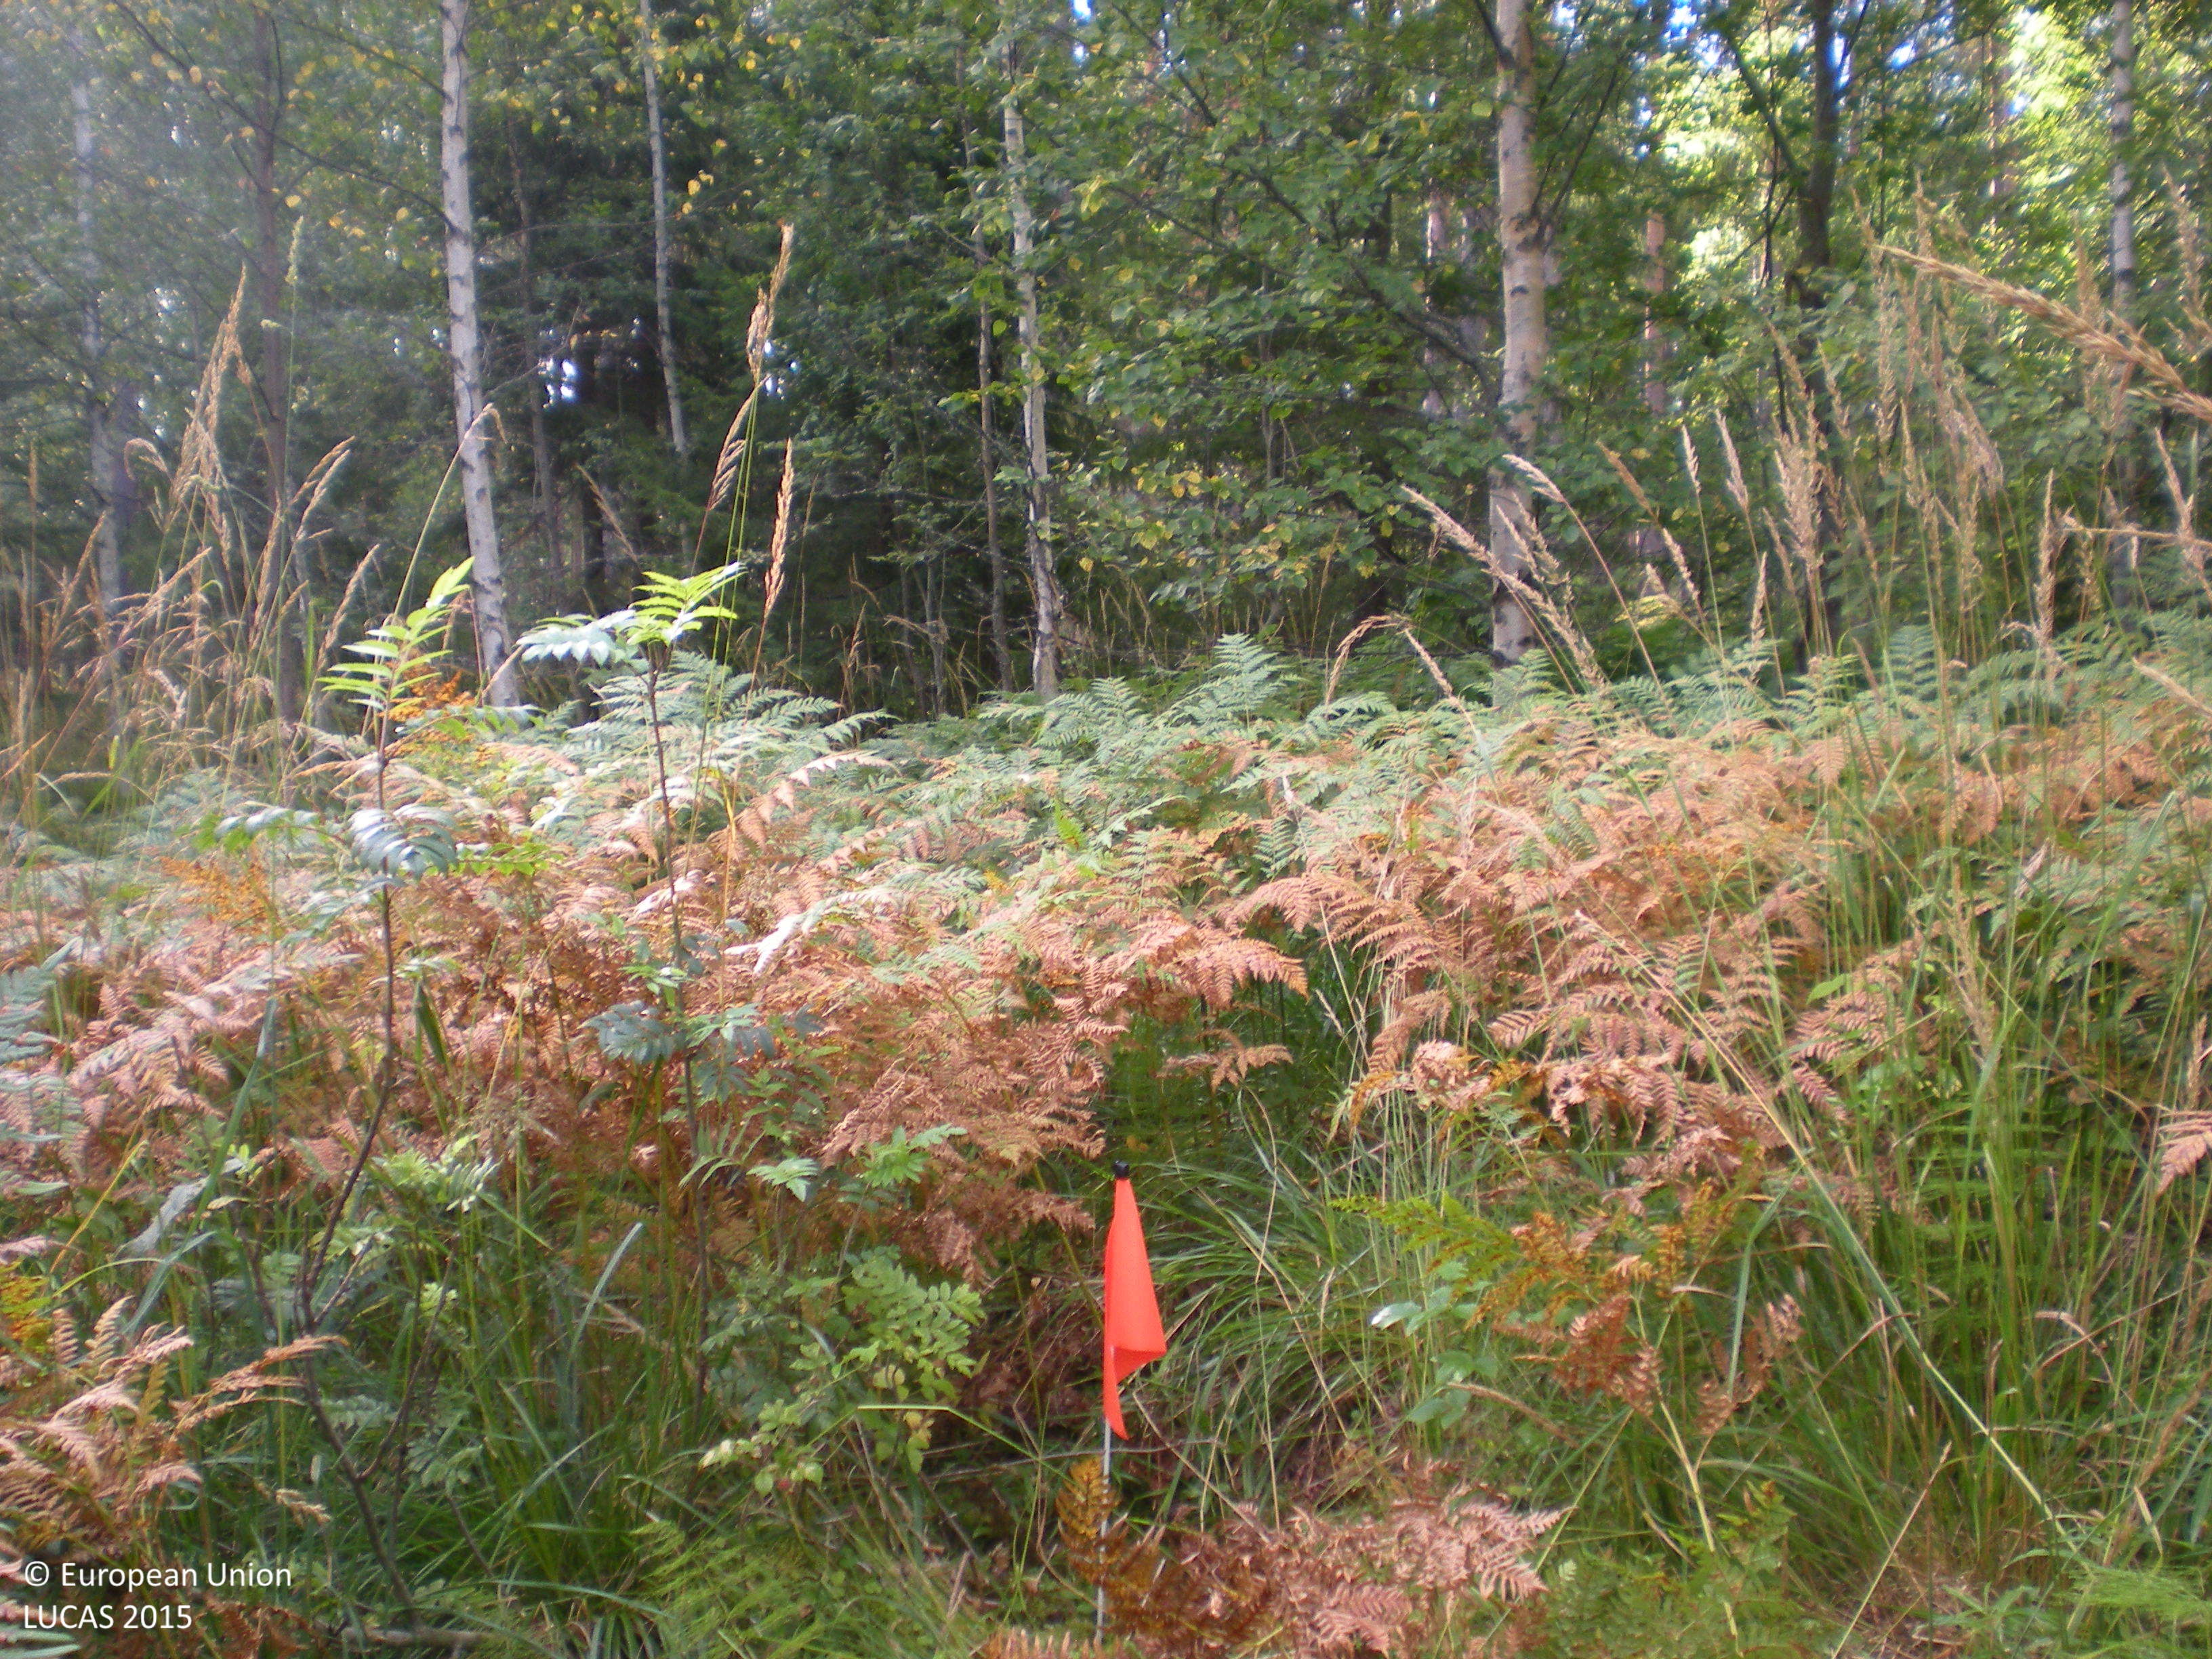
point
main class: Woodland
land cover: Spruce dominated mixed woodland
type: boreal forest
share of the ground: 50 - 75 %
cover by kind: herbaceous plants 35 %, coniferous forest trees 30 %, broadleaved forest trees 25 %, shrubs 5 %, lichens and mosses 5 %
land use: Forestry
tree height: > 5 m
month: August
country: SE
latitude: 60.4522
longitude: 17.1343
